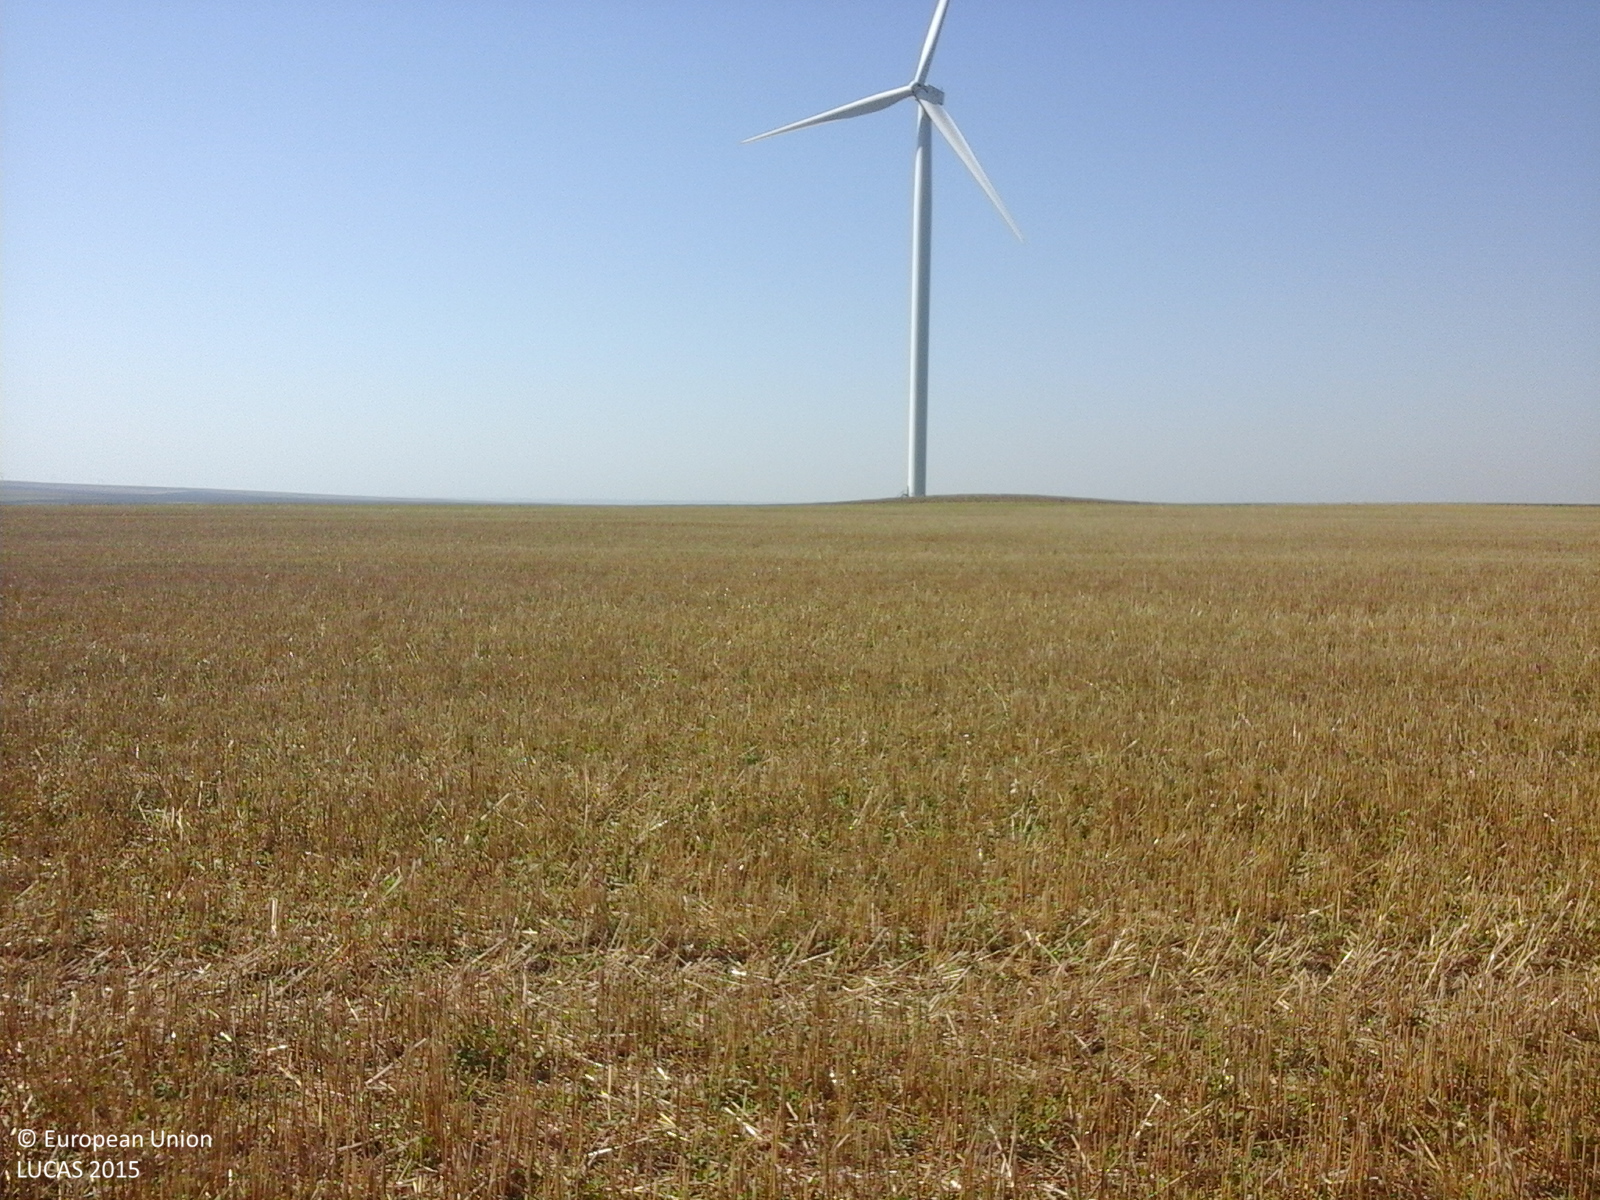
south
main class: Cropland
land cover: Common wheat
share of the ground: > 75 %
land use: Agriculture (excluding fallow land and kitchen gardens)
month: August
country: RO
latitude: 44.5456
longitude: 28.5397
